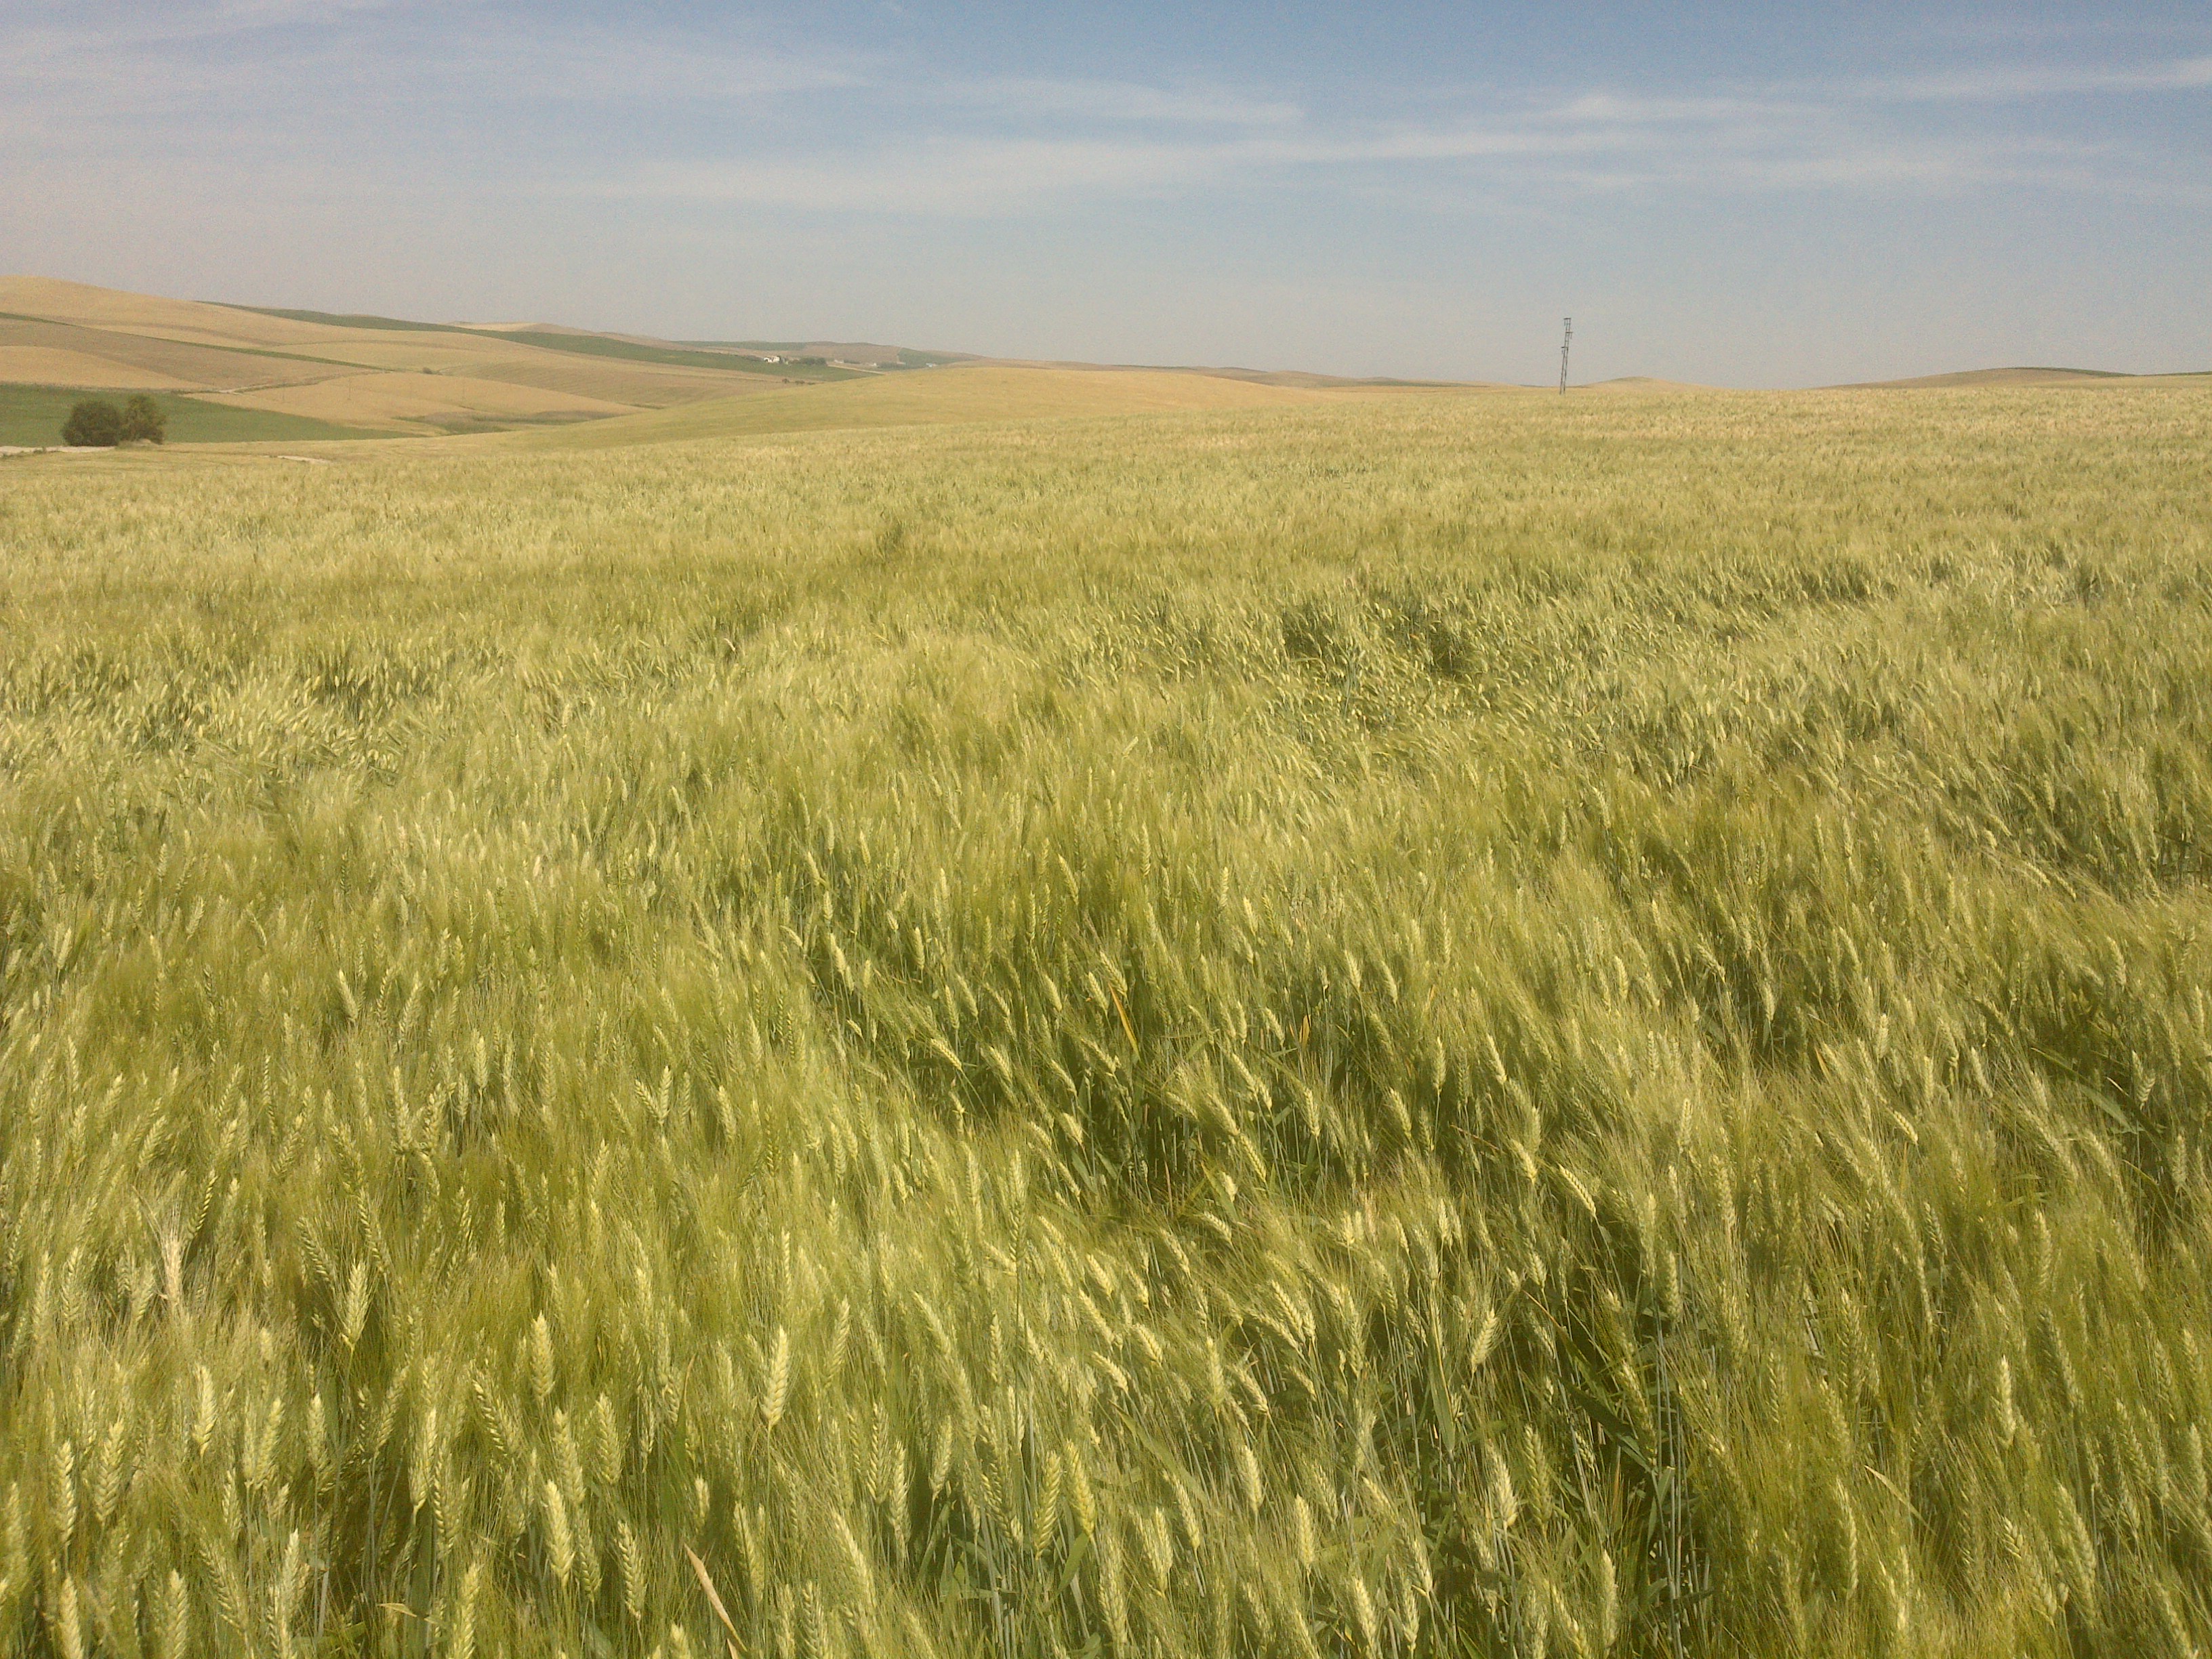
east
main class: Cropland
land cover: Durum wheat
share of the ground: > 75 %
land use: Agriculture (excluding fallow land and kitchen gardens)
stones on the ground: 25 - 50 %
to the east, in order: Durum wheat; Electric lines; Durum wheat
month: May
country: ES
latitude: 37.8331
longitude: -4.5657
